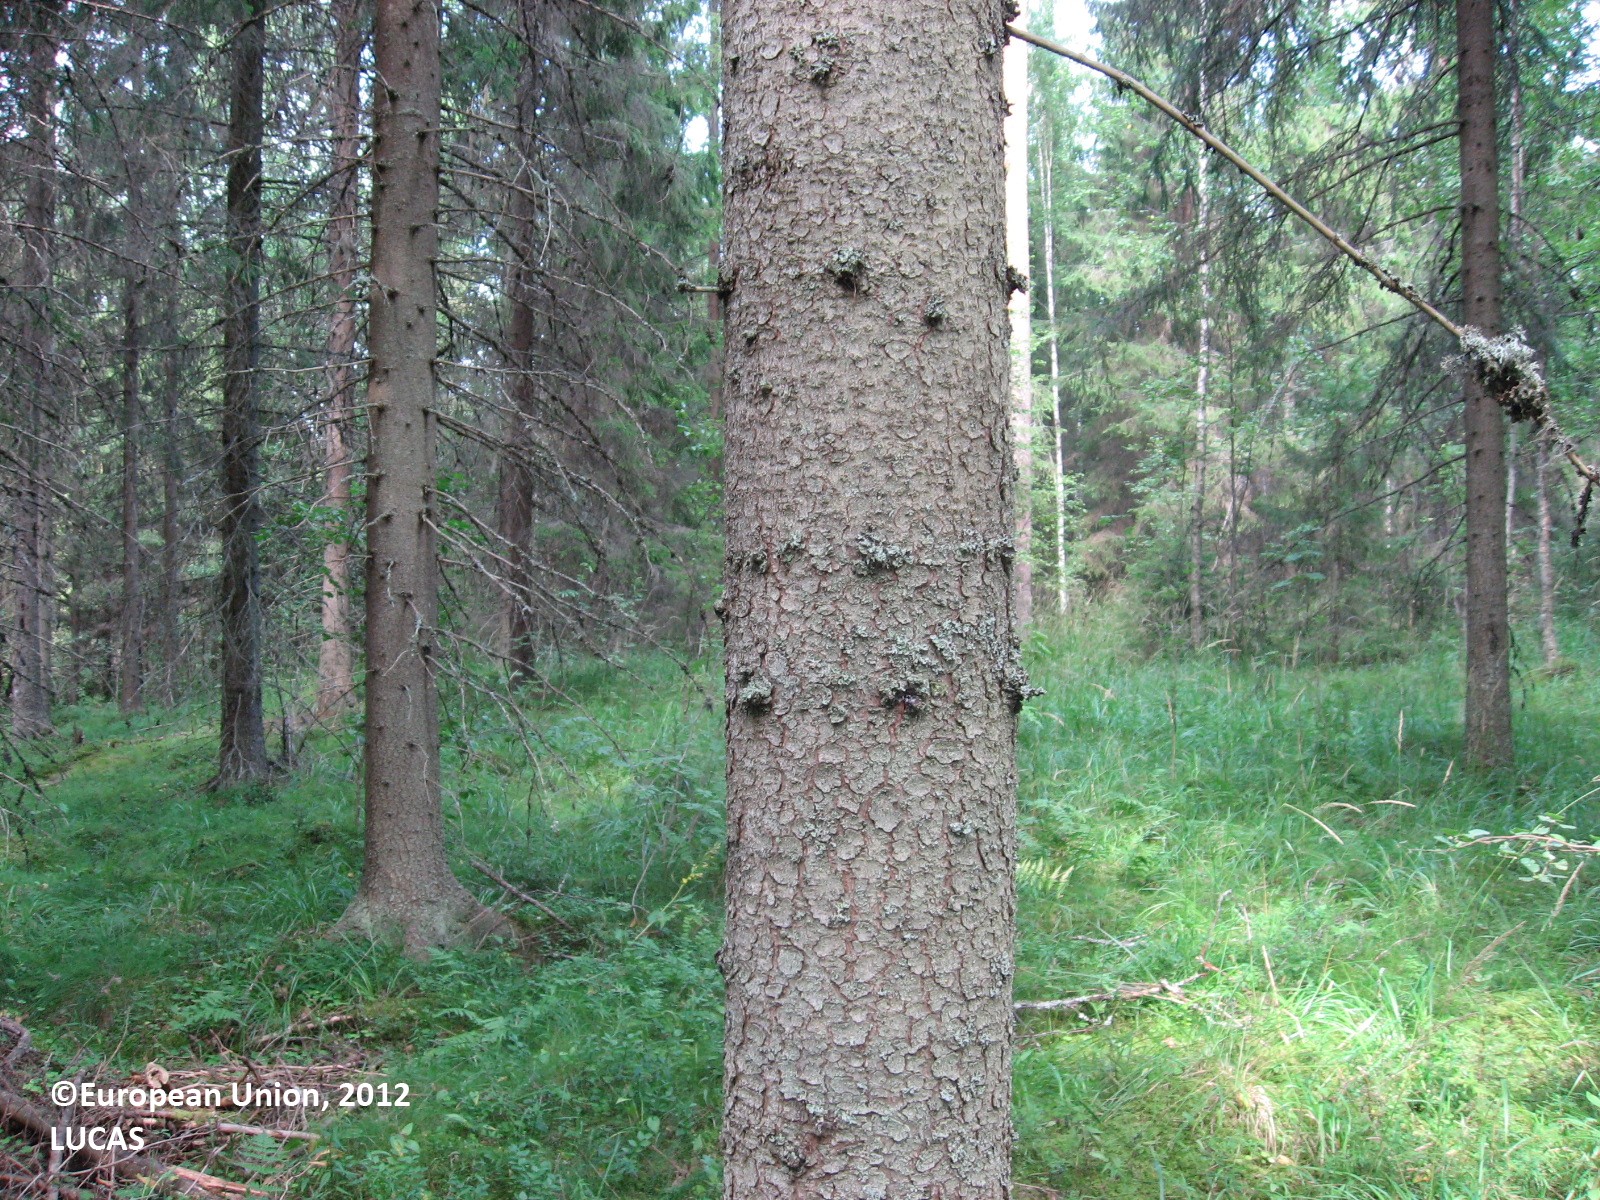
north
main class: Woodland
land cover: Spruce dominated coniferous woodland
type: boreal forest
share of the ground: 50 - 75 %
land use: Forestry
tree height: > 5 m
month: August
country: FI
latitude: 61.6143
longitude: 24.8311
